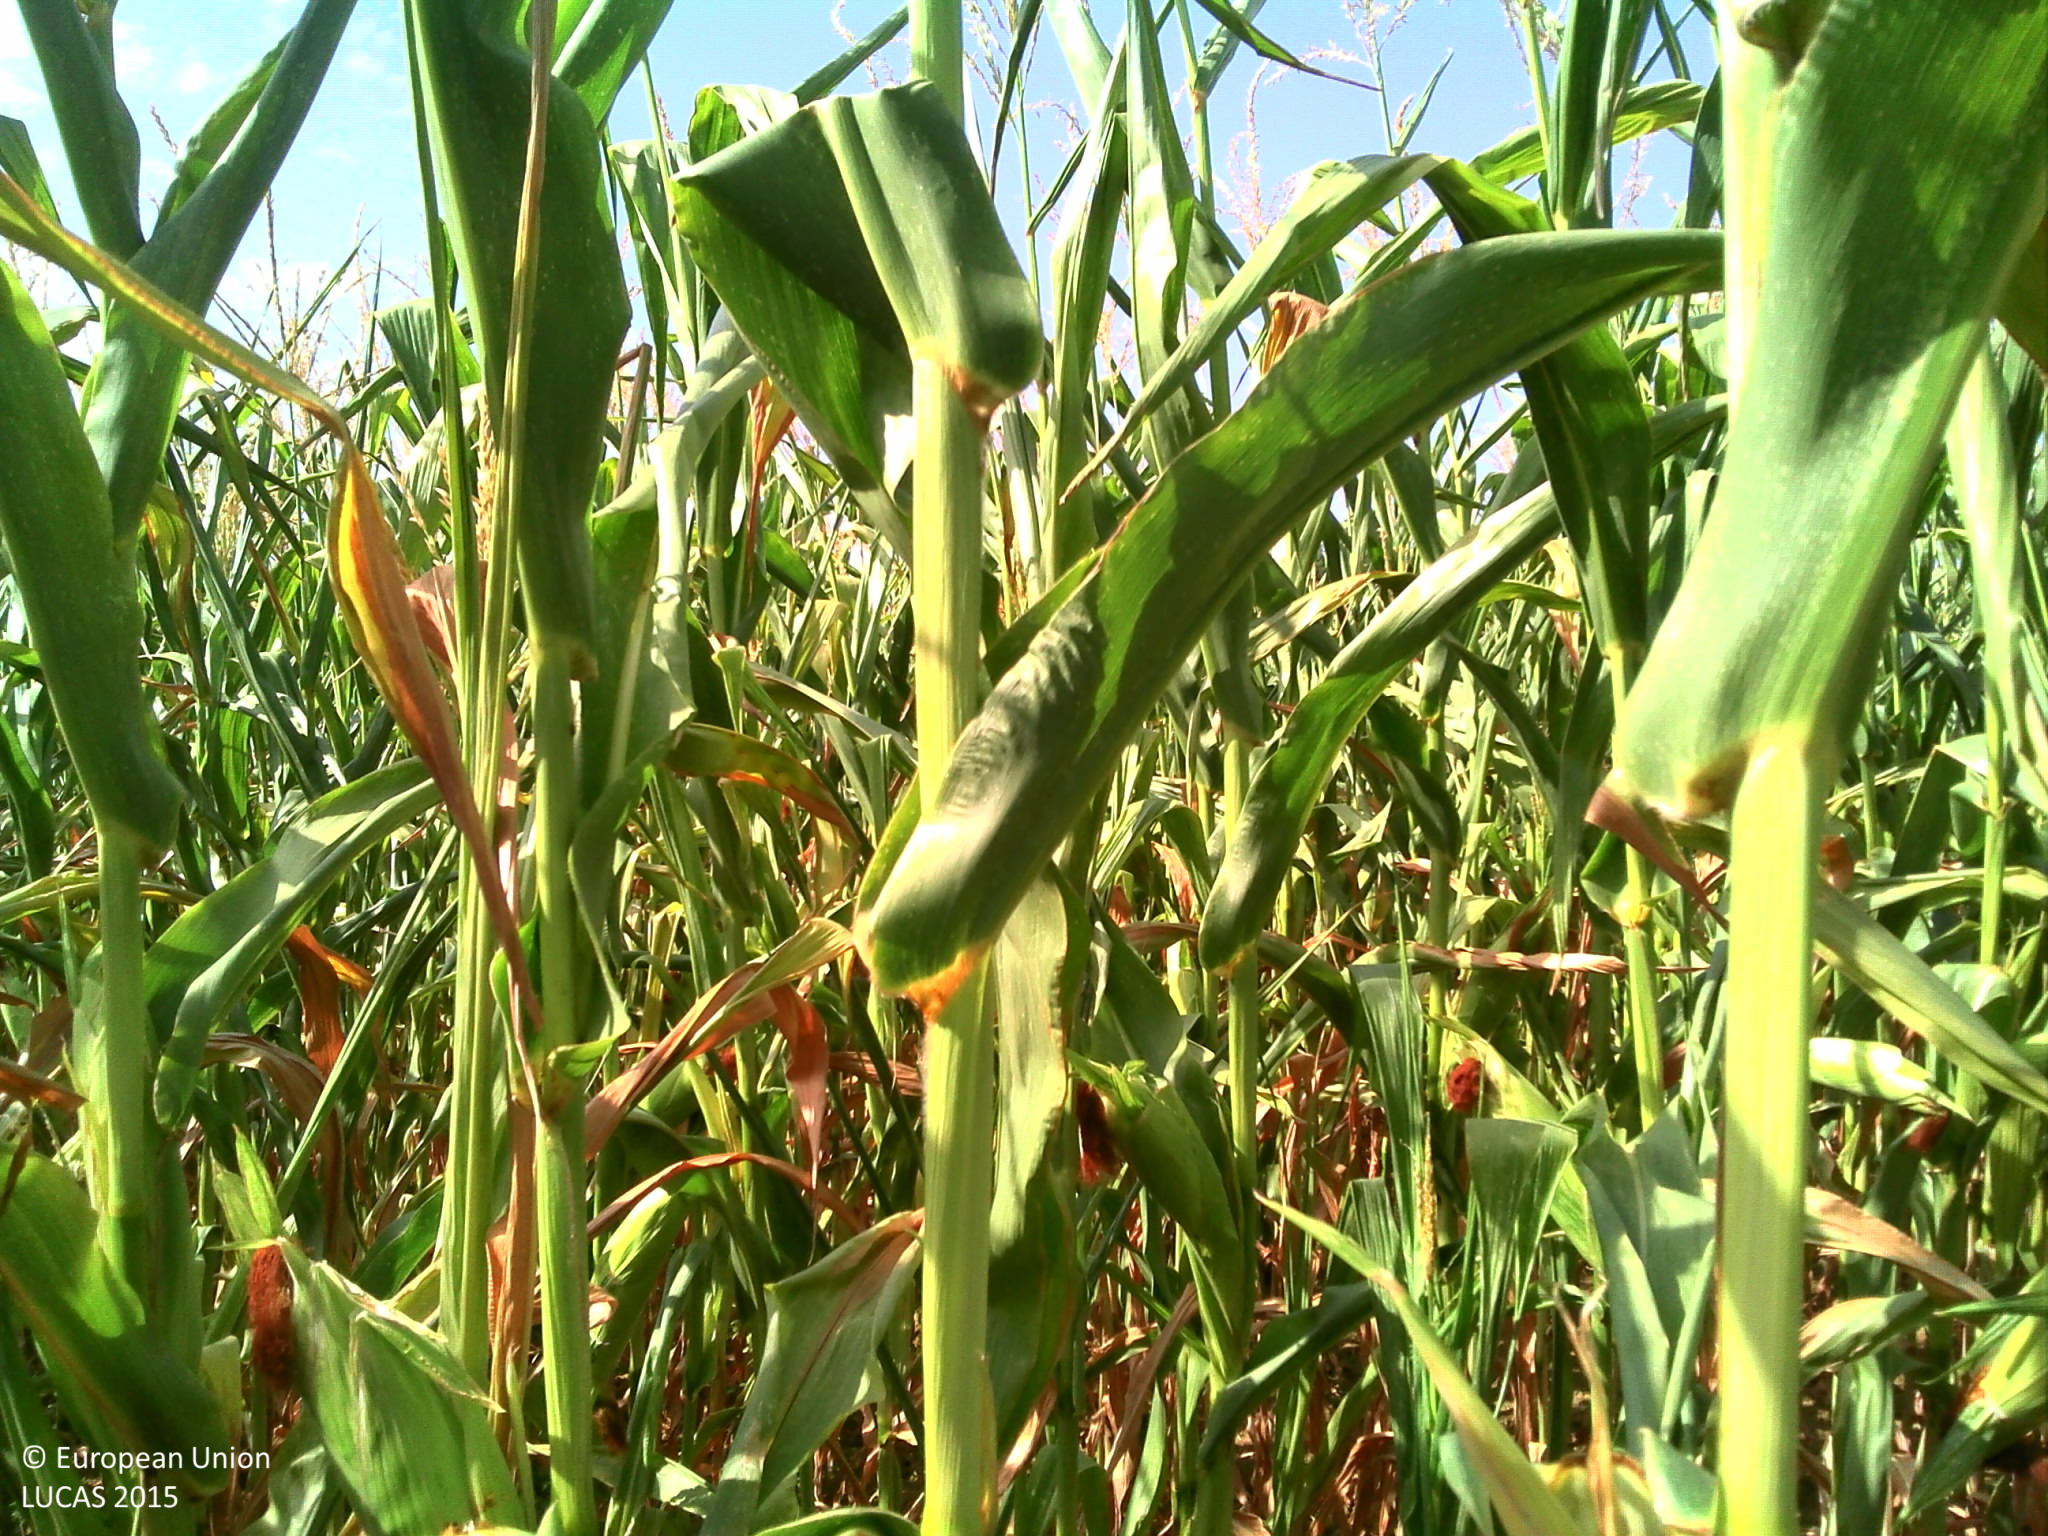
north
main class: Cropland
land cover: Maize
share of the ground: 50 - 75 %
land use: Agriculture (excluding fallow land and kitchen gardens)
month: August
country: FR
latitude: 44.5593
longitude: 0.6133
